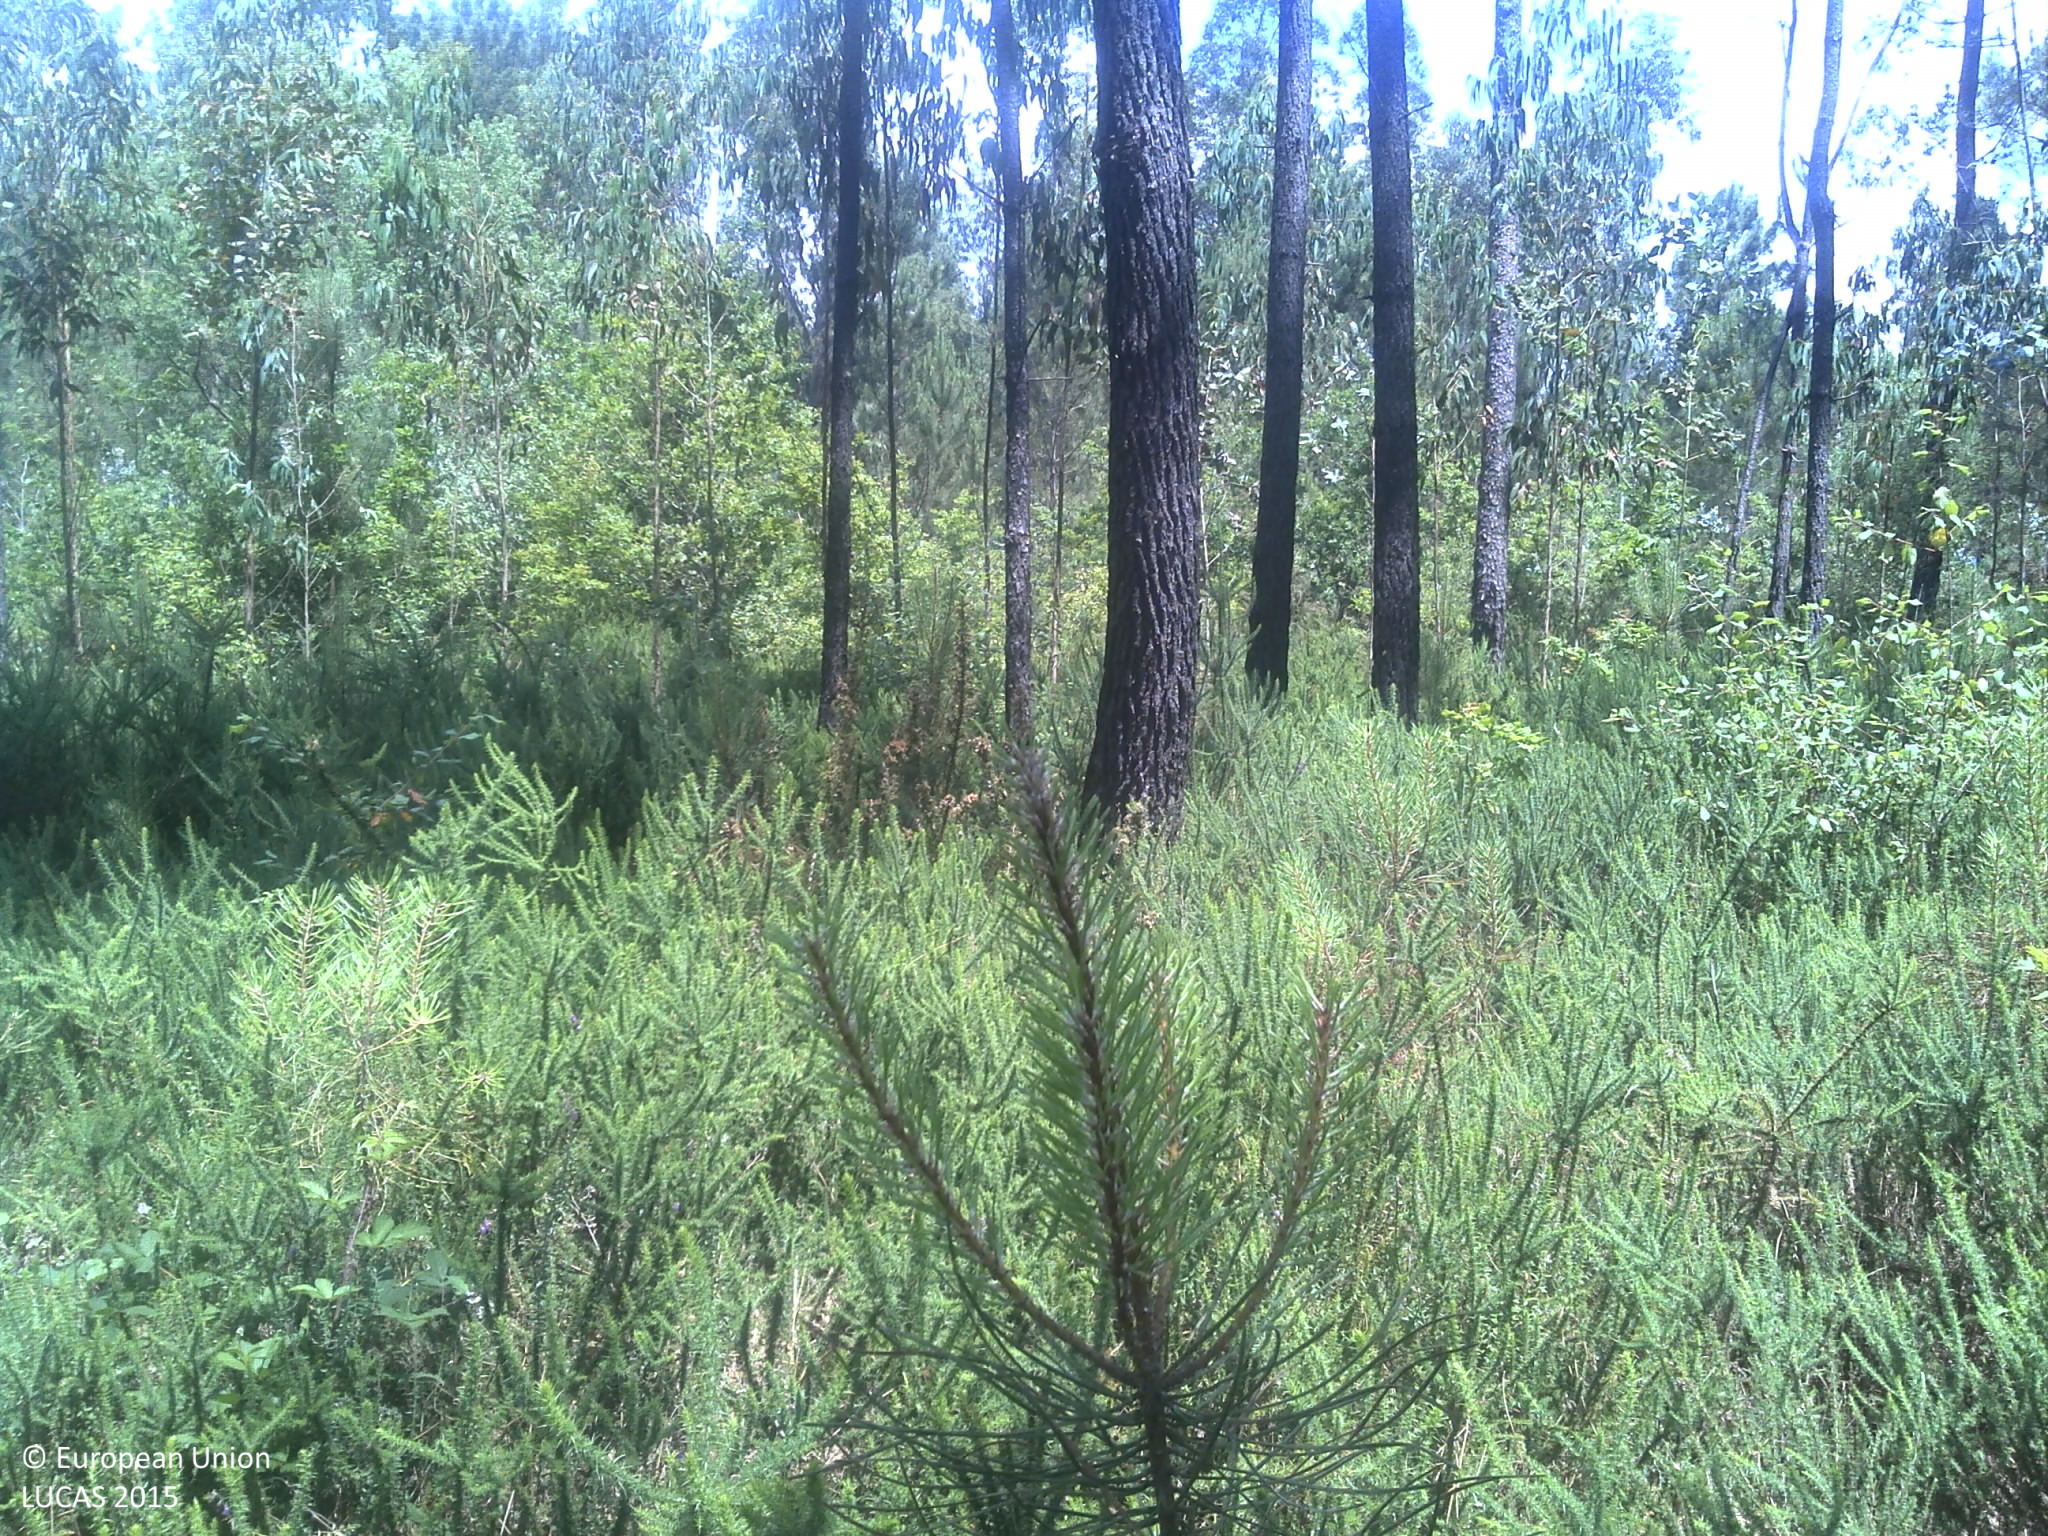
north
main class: Woodland
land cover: Pine dominated coniferous woodland
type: coniferous forest of the mediterranean region
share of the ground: 50 - 75 %
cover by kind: coniferous forest trees 70 %, shrubs 25 %, broadleaved forest trees 5 %
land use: Forestry
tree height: > 5 m
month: June
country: PT
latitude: 41.6234
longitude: -8.5585
